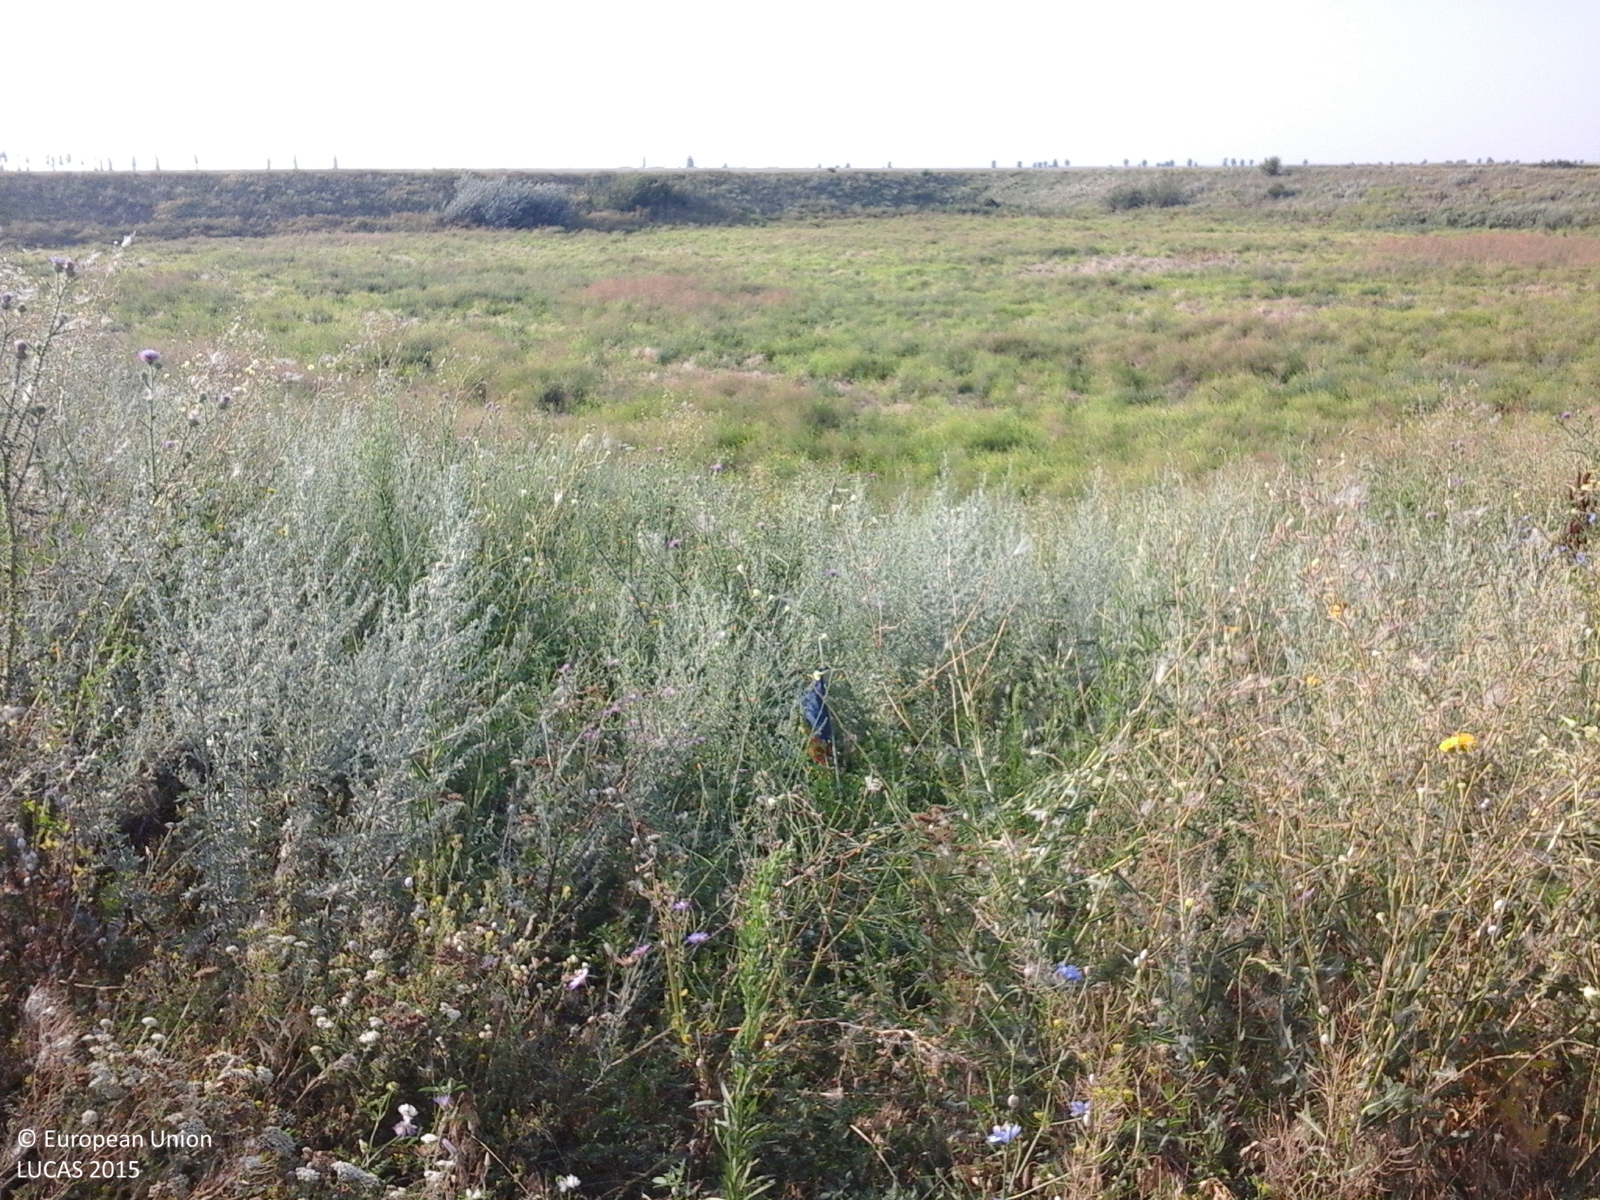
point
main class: Grassland
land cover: Spontaneously vegetated surfaces
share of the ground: > 75 %
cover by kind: herbaceous plants 100 %
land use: Fallow land
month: July
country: RO
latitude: 44.6536
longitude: 27.0678
